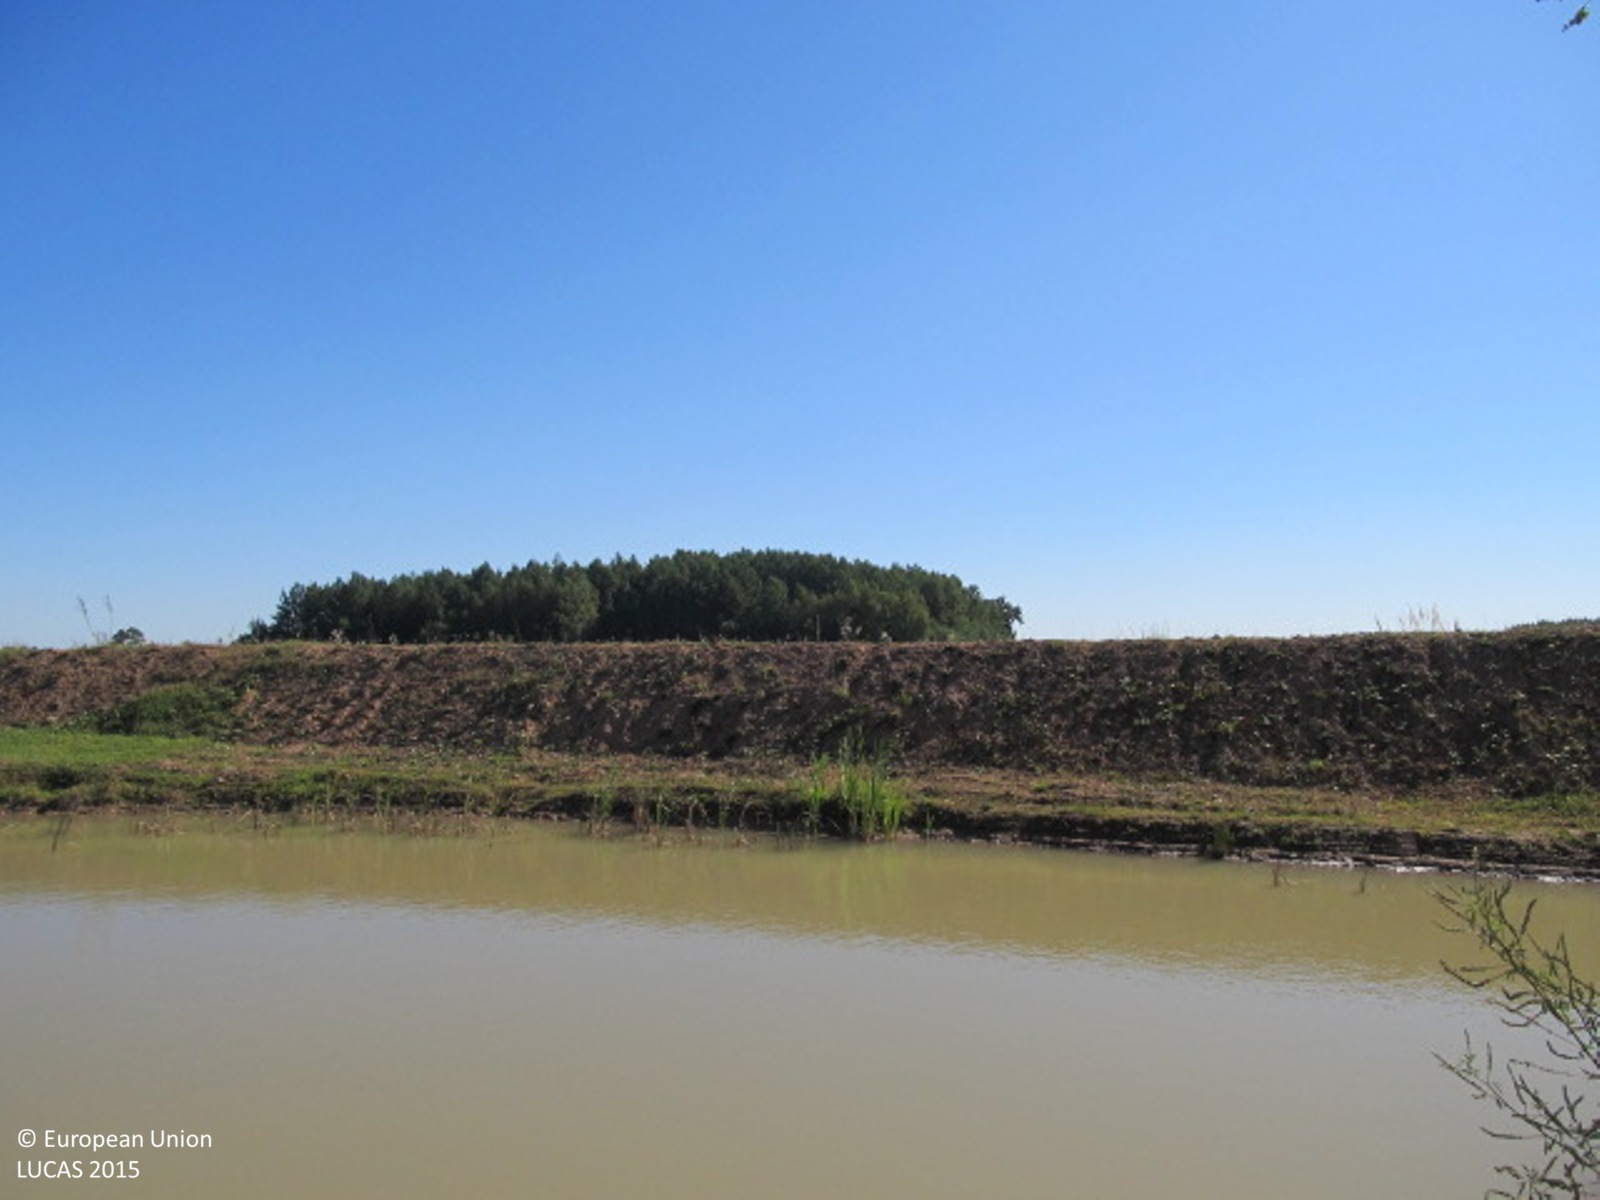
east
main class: Grassland
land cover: Spontaneously vegetated surfaces
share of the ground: 50 - 75 %
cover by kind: herbaceous plants 50 %, unconsolidated bare surface 45 %
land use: Amenities, museums, leisure
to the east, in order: Spontaneously vegetated surfaces; Inland fresh water bodies; Spontaneously vegetated surfaces; Dry pulses
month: August
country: LT
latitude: 56.3099
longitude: 22.4226
